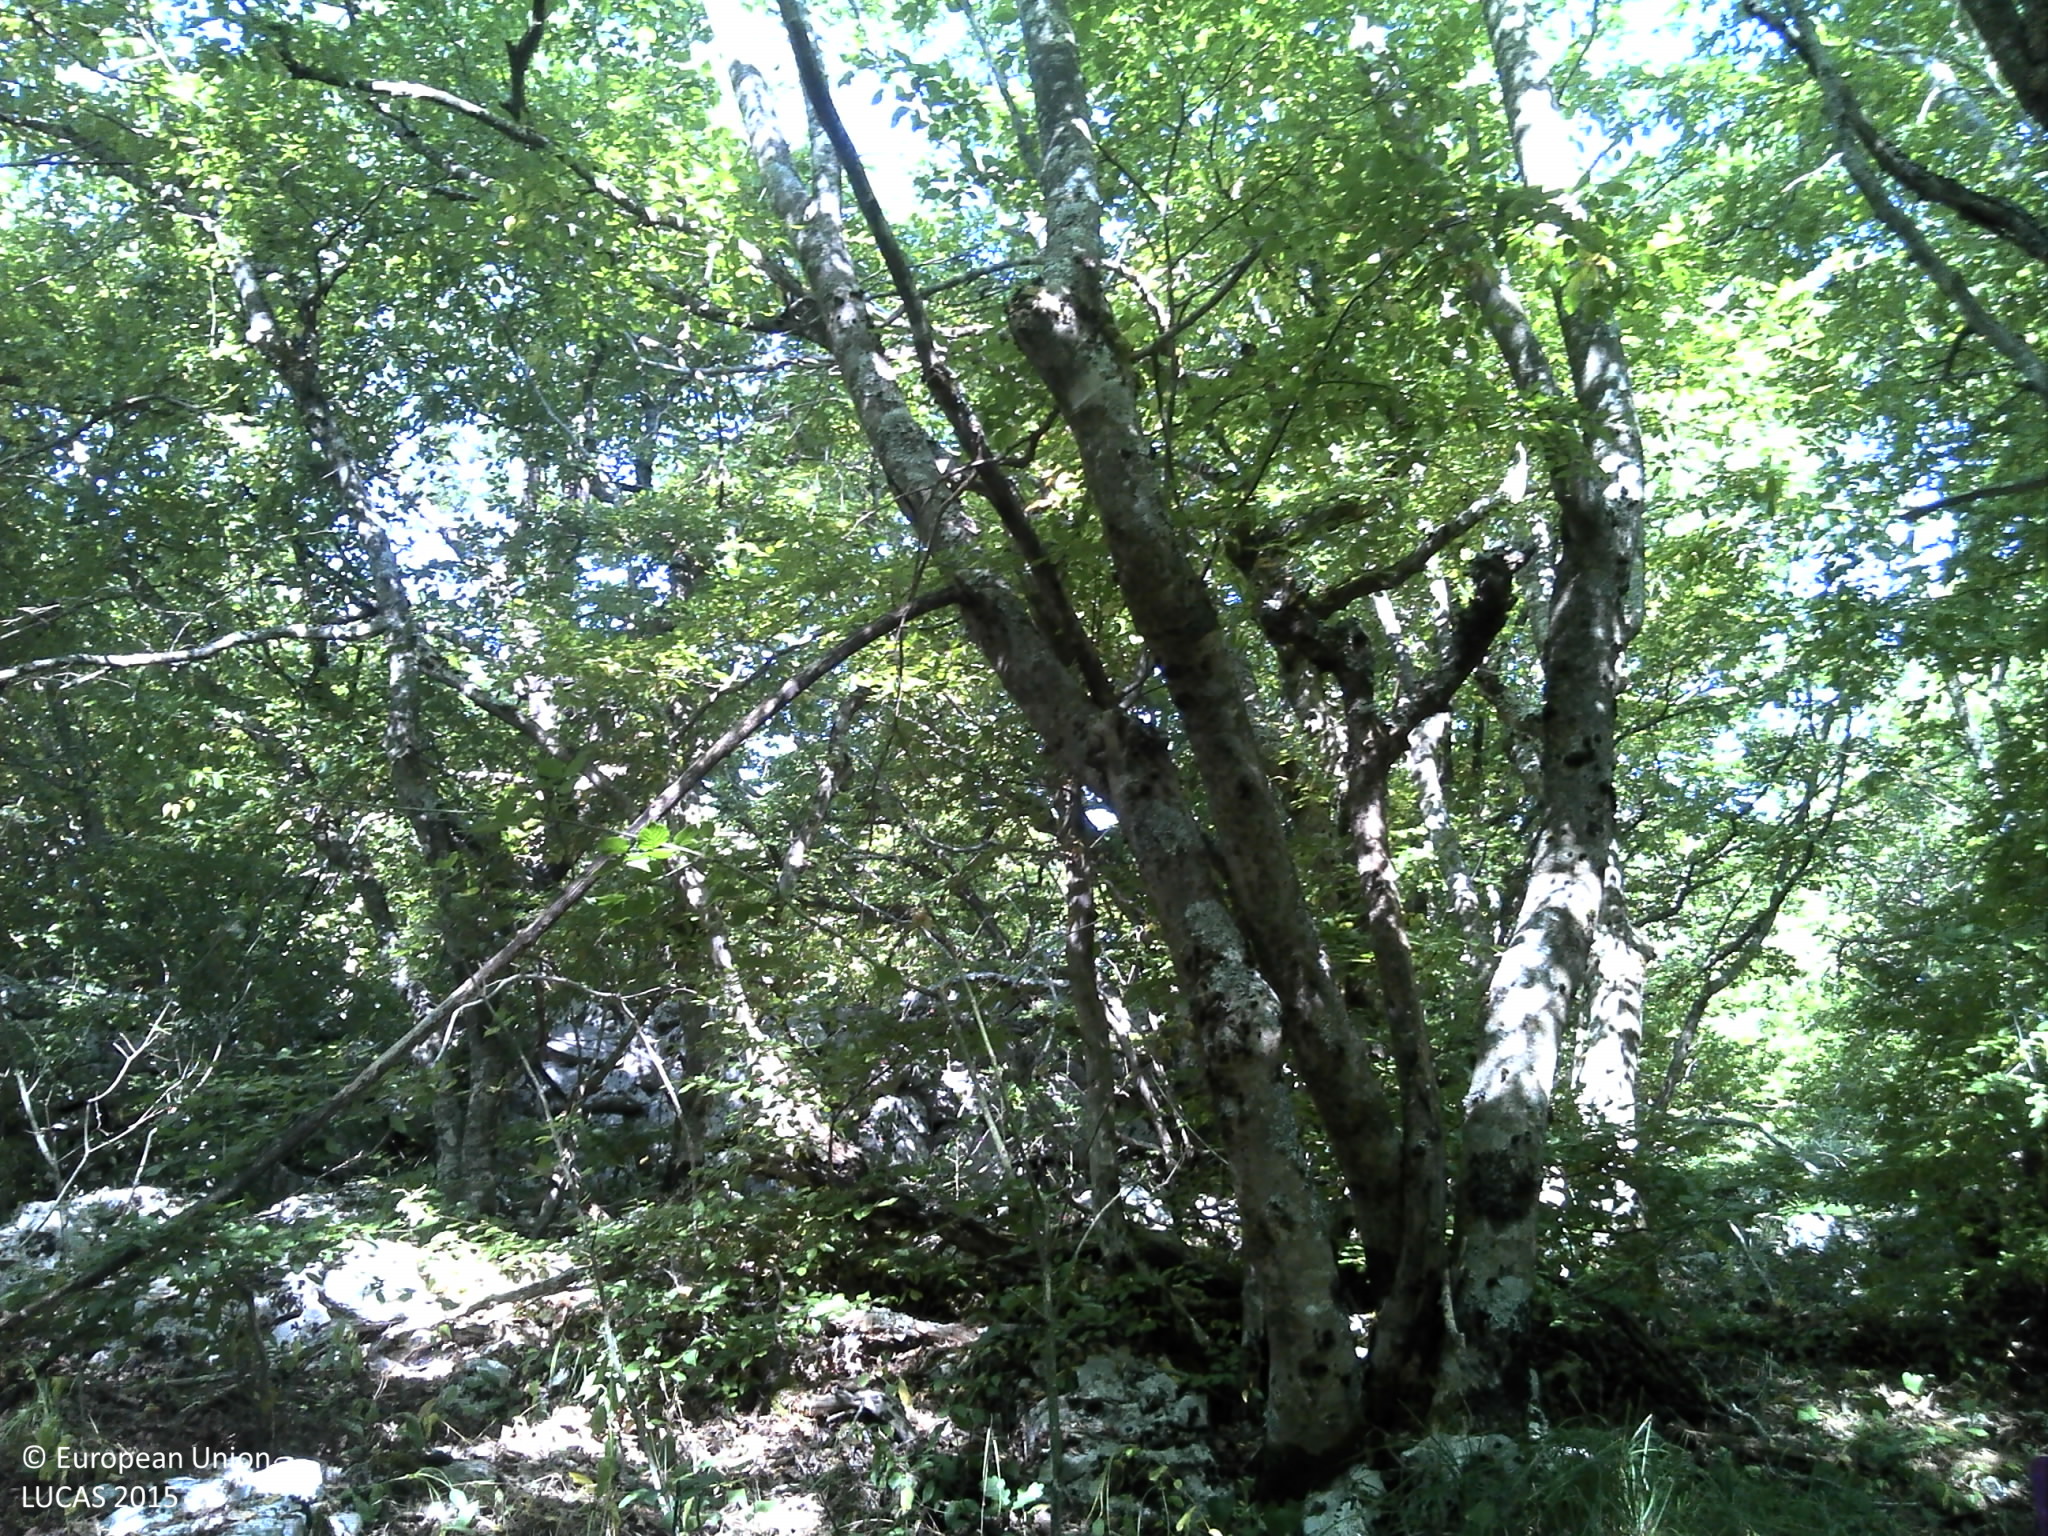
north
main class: Woodland
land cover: Broadleaved woodland
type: thermophilous deciduous forest
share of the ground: 50 - 75 %
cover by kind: broadleaved forest trees 70 %, shrubs 15 %, herbaceous plants 10 %, consolidated bare surface 5 %
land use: Semi-natural and natural areas not in use
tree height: > 5 m
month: July
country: HR
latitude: 43.5308
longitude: 17.0574
